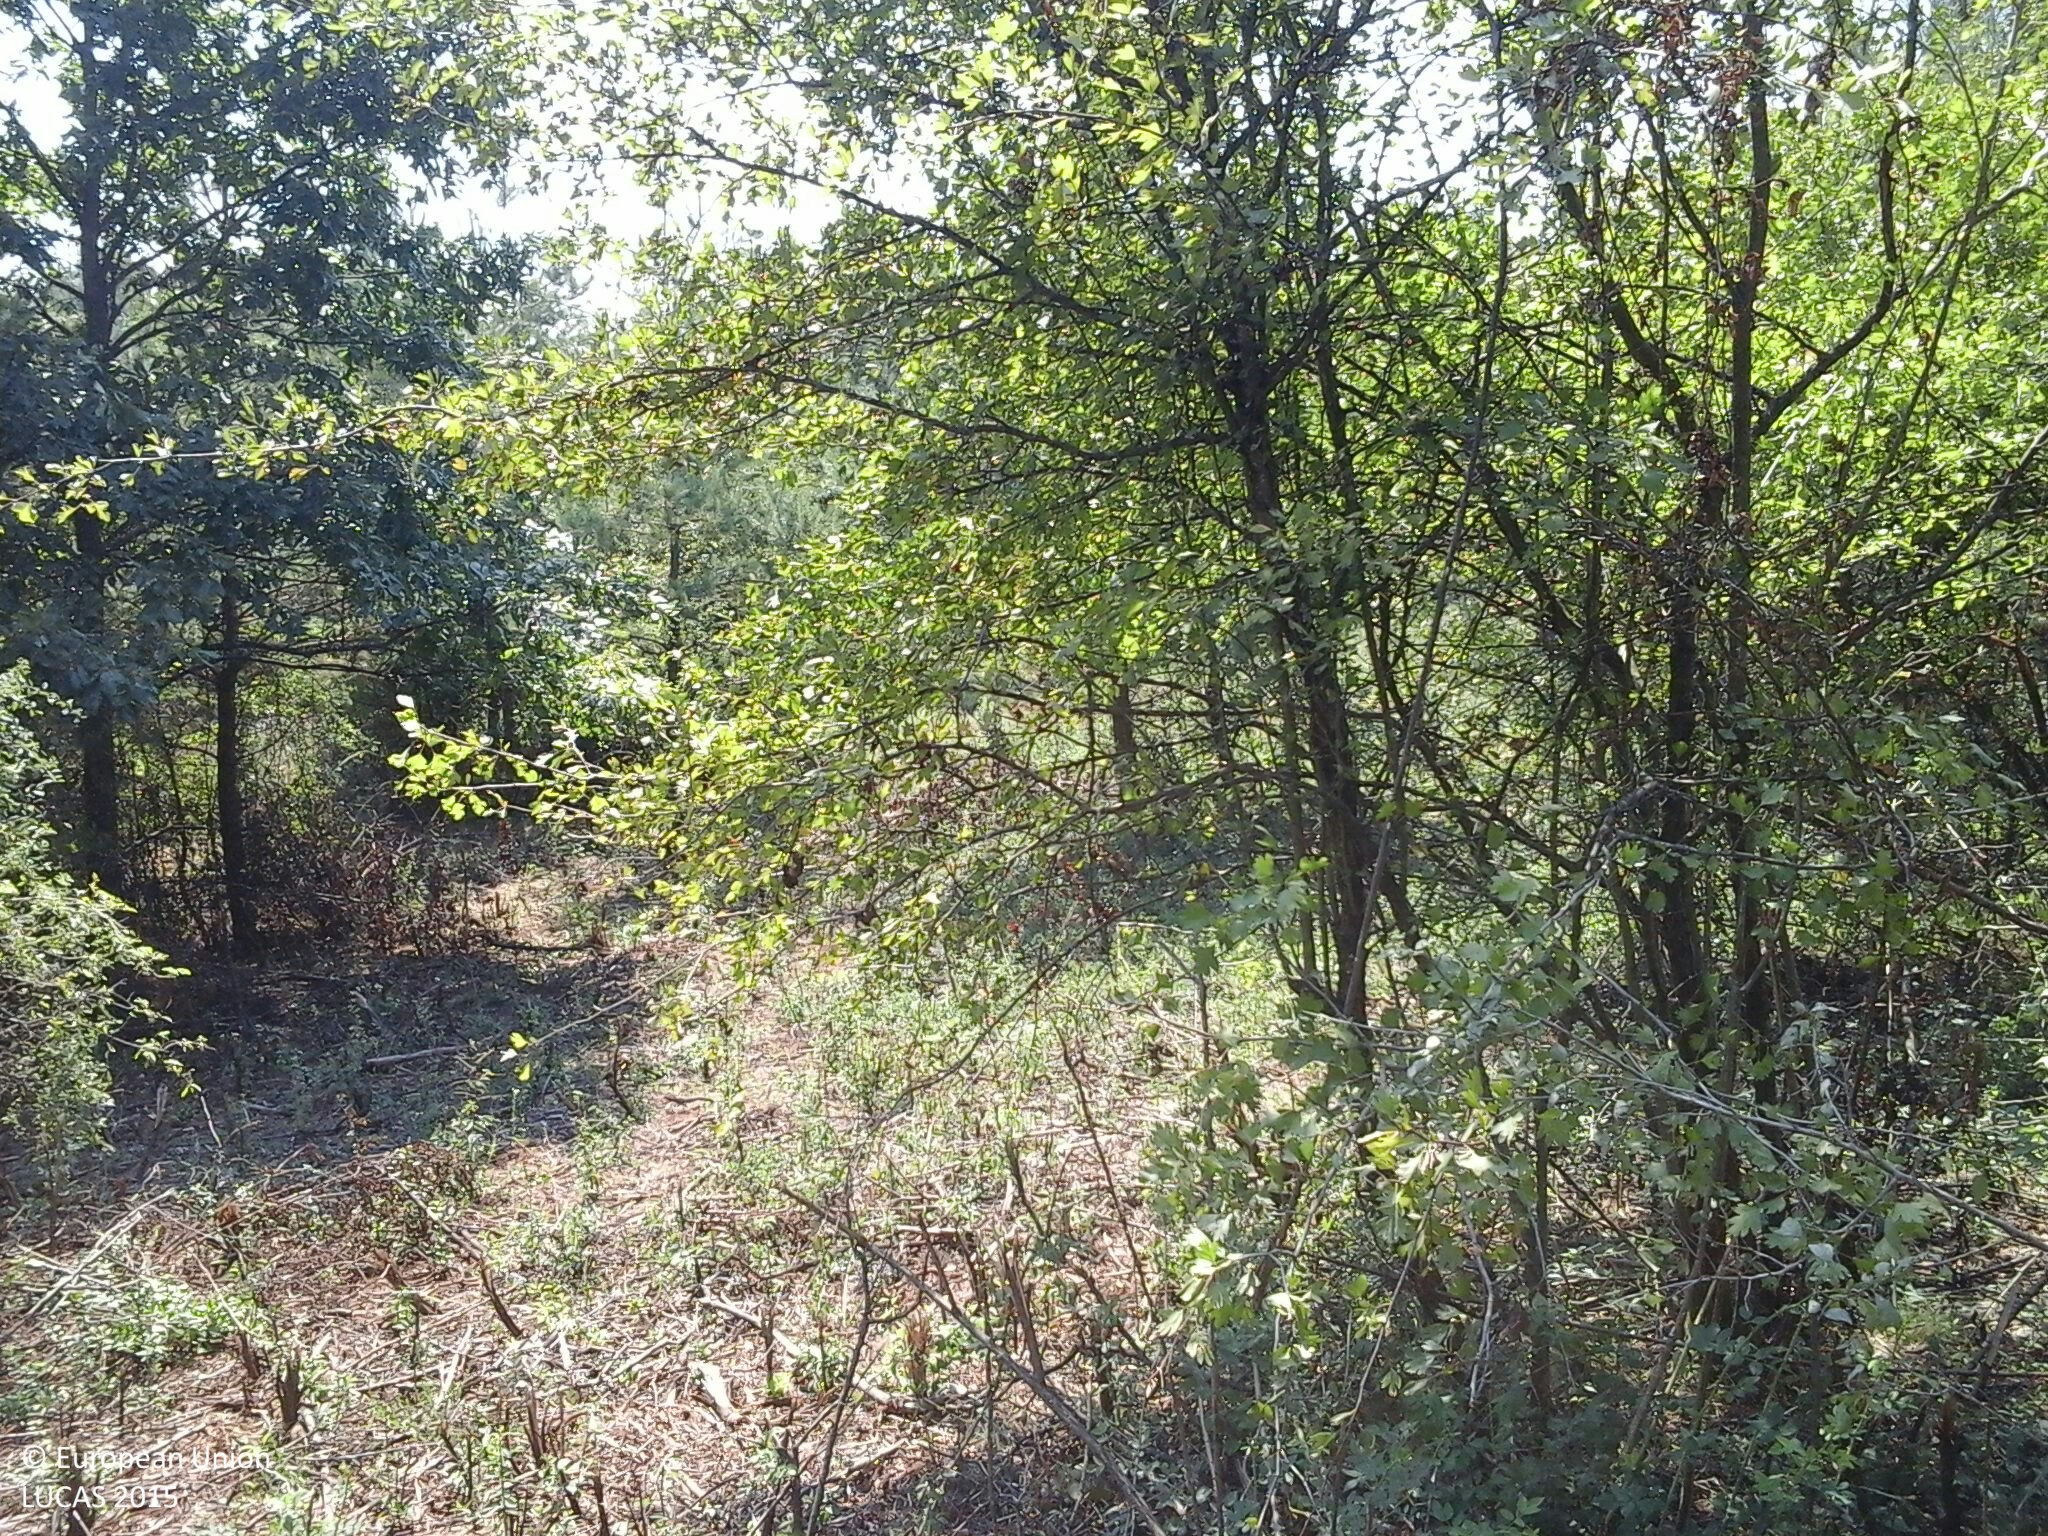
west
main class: Woodland
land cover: Pine dominated mixed woodland
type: hemiboreal forest and nemoral coniferous forest and mixed broadleaved-coniferous forest
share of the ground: > 75 %
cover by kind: herbaceous plants 40 %, shrubs 30 %, coniferous forest trees 15 %, broadleaved forest trees 15 %
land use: Forestry
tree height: > 5 m
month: August
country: HU
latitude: 48.4220
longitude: 20.7533
